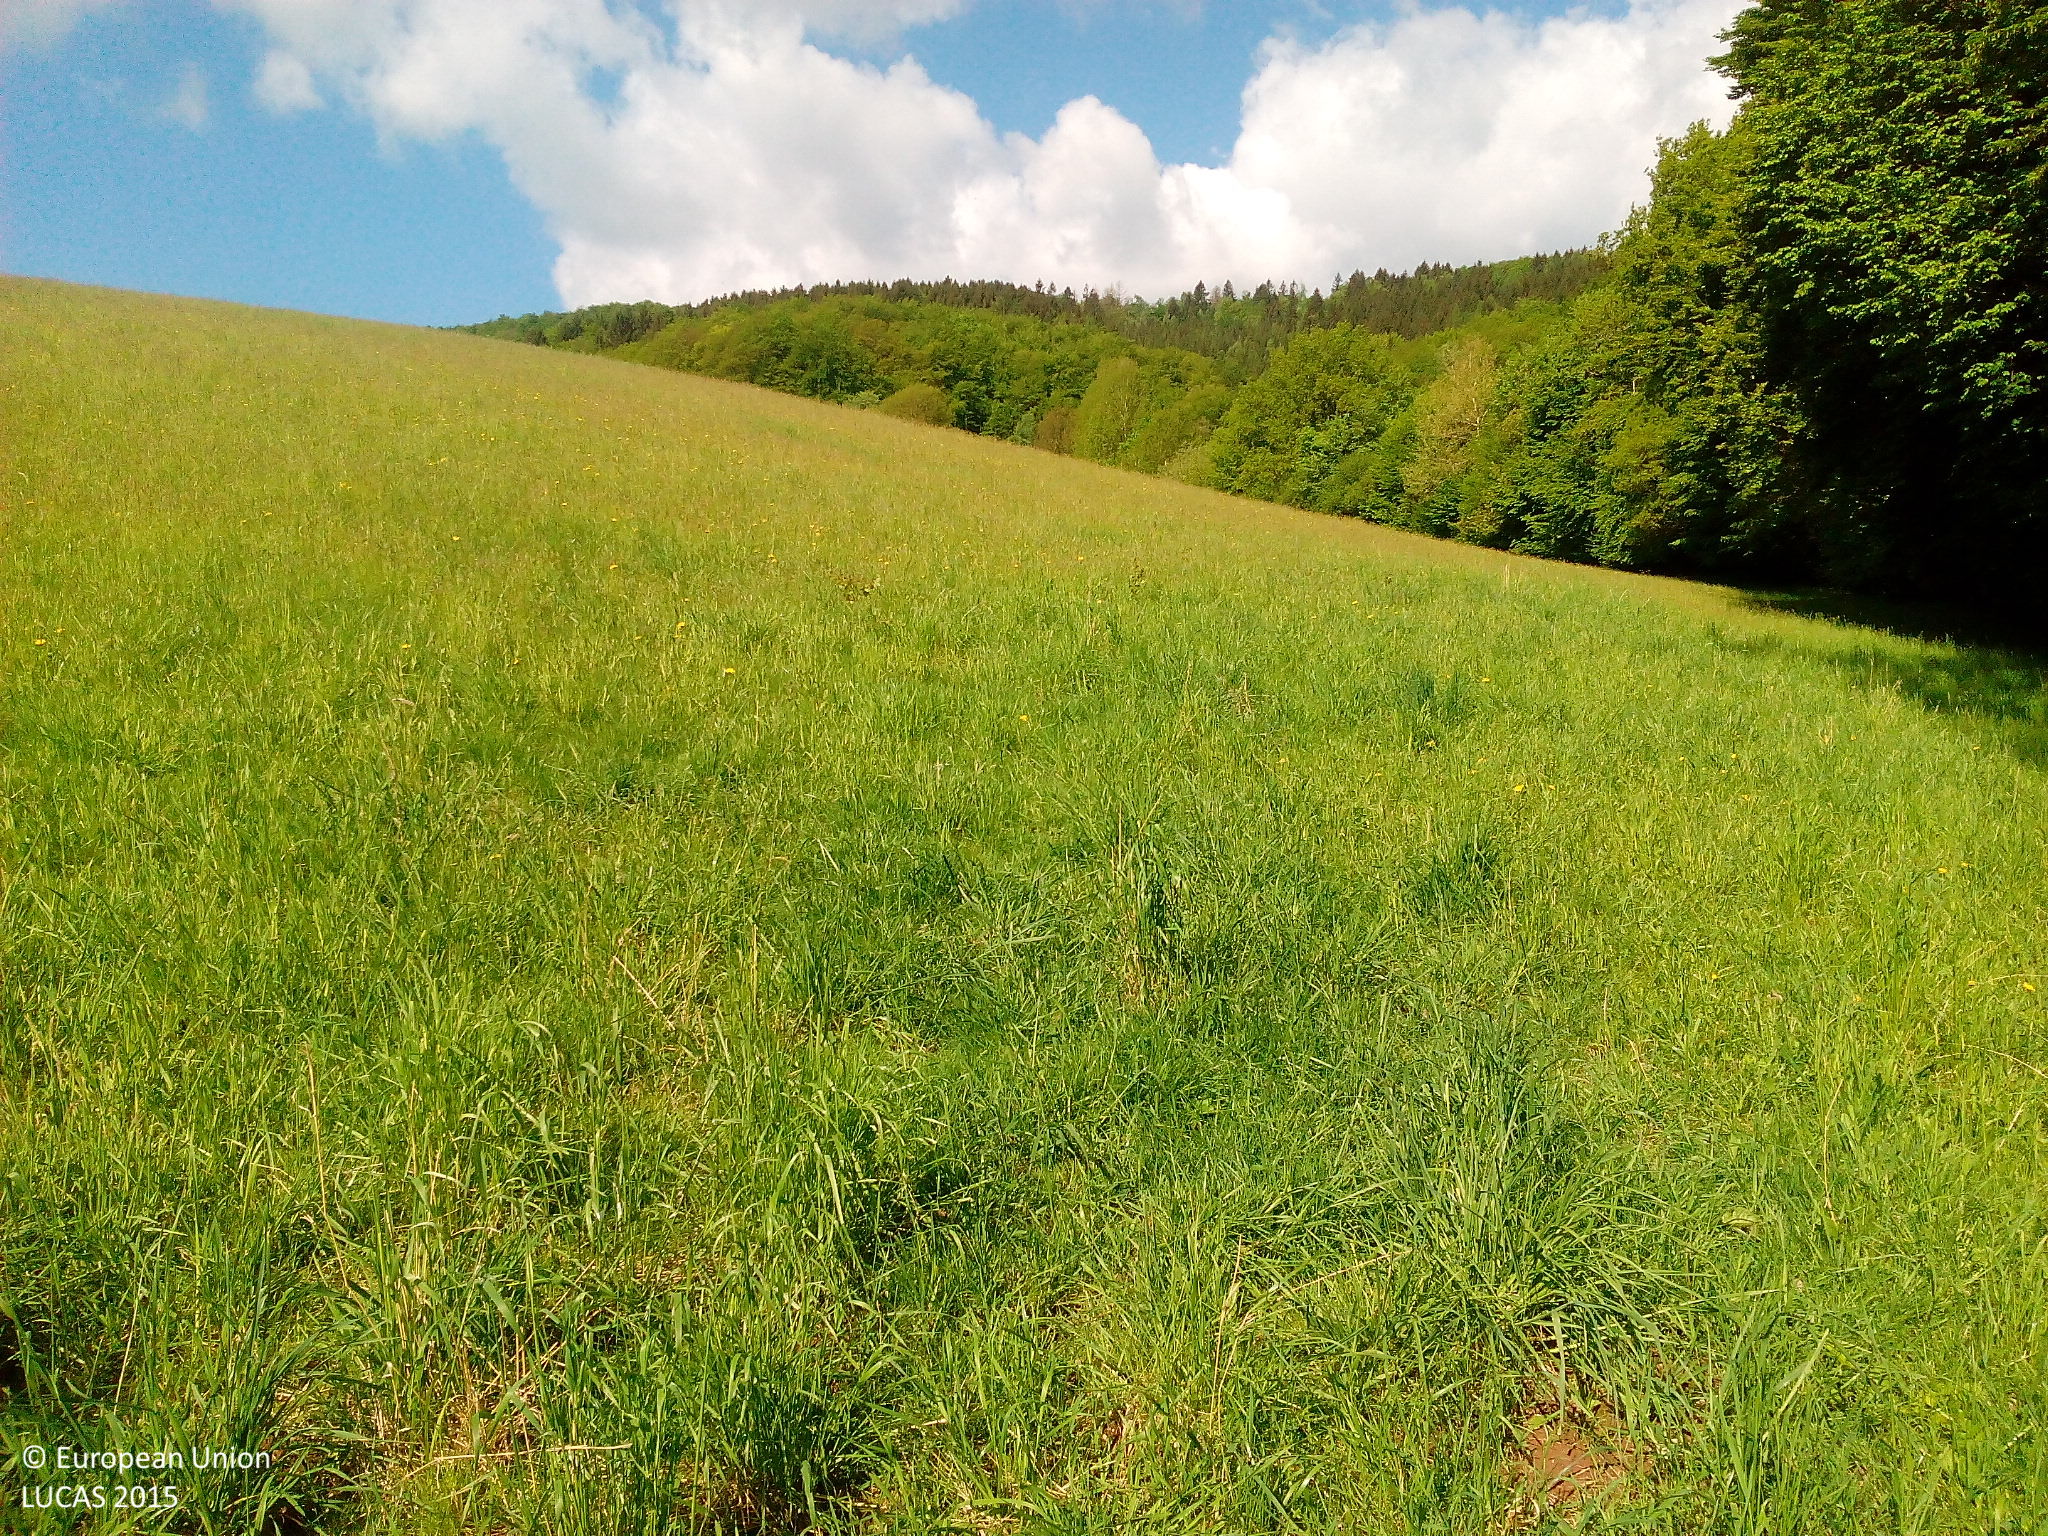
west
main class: Grassland
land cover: Grassland without tree/shrub cover
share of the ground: > 75 %
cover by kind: herbaceous plants 100 %
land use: Agriculture (excluding fallow land and kitchen gardens)
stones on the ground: < 10 %
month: May
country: DE
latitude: 51.2629
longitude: 9.8711
